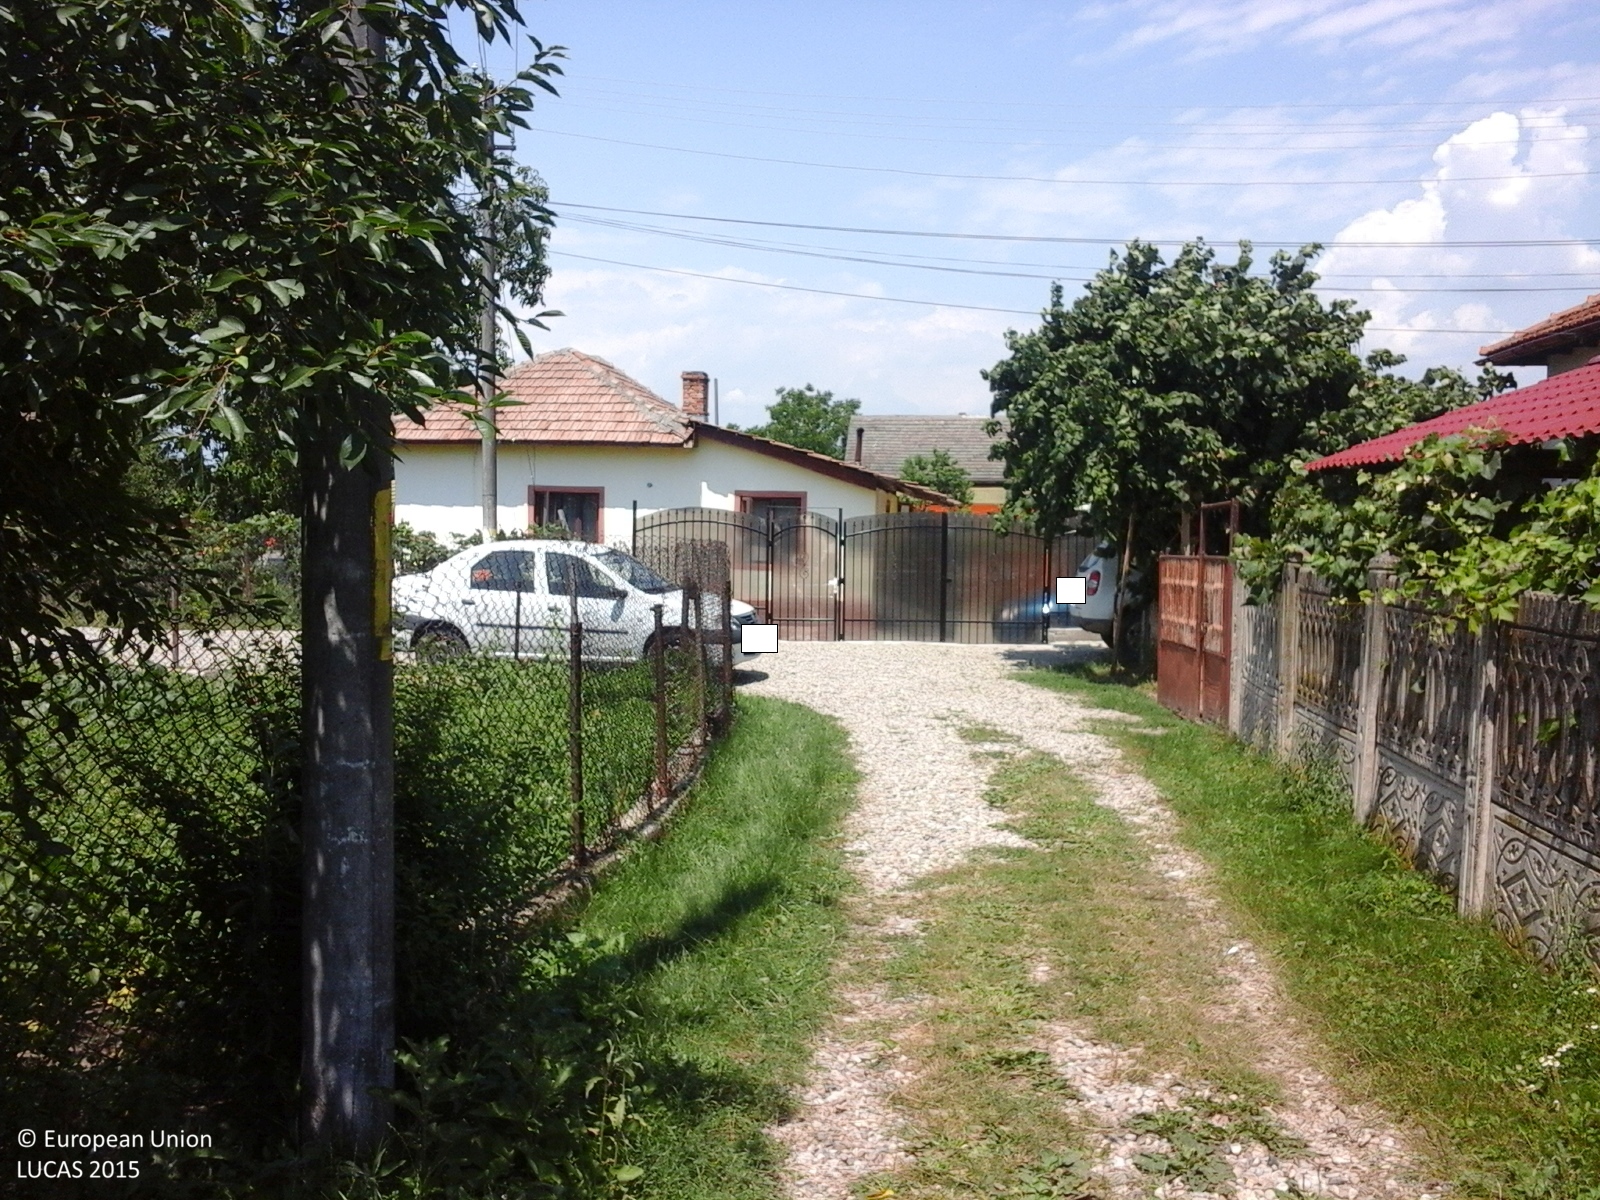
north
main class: Grassland
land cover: Spontaneously vegetated surfaces
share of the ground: > 75 %
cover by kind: herbaceous plants 100 %
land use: Fallow land
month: July
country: RO
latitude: 45.0616
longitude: 24.3860
